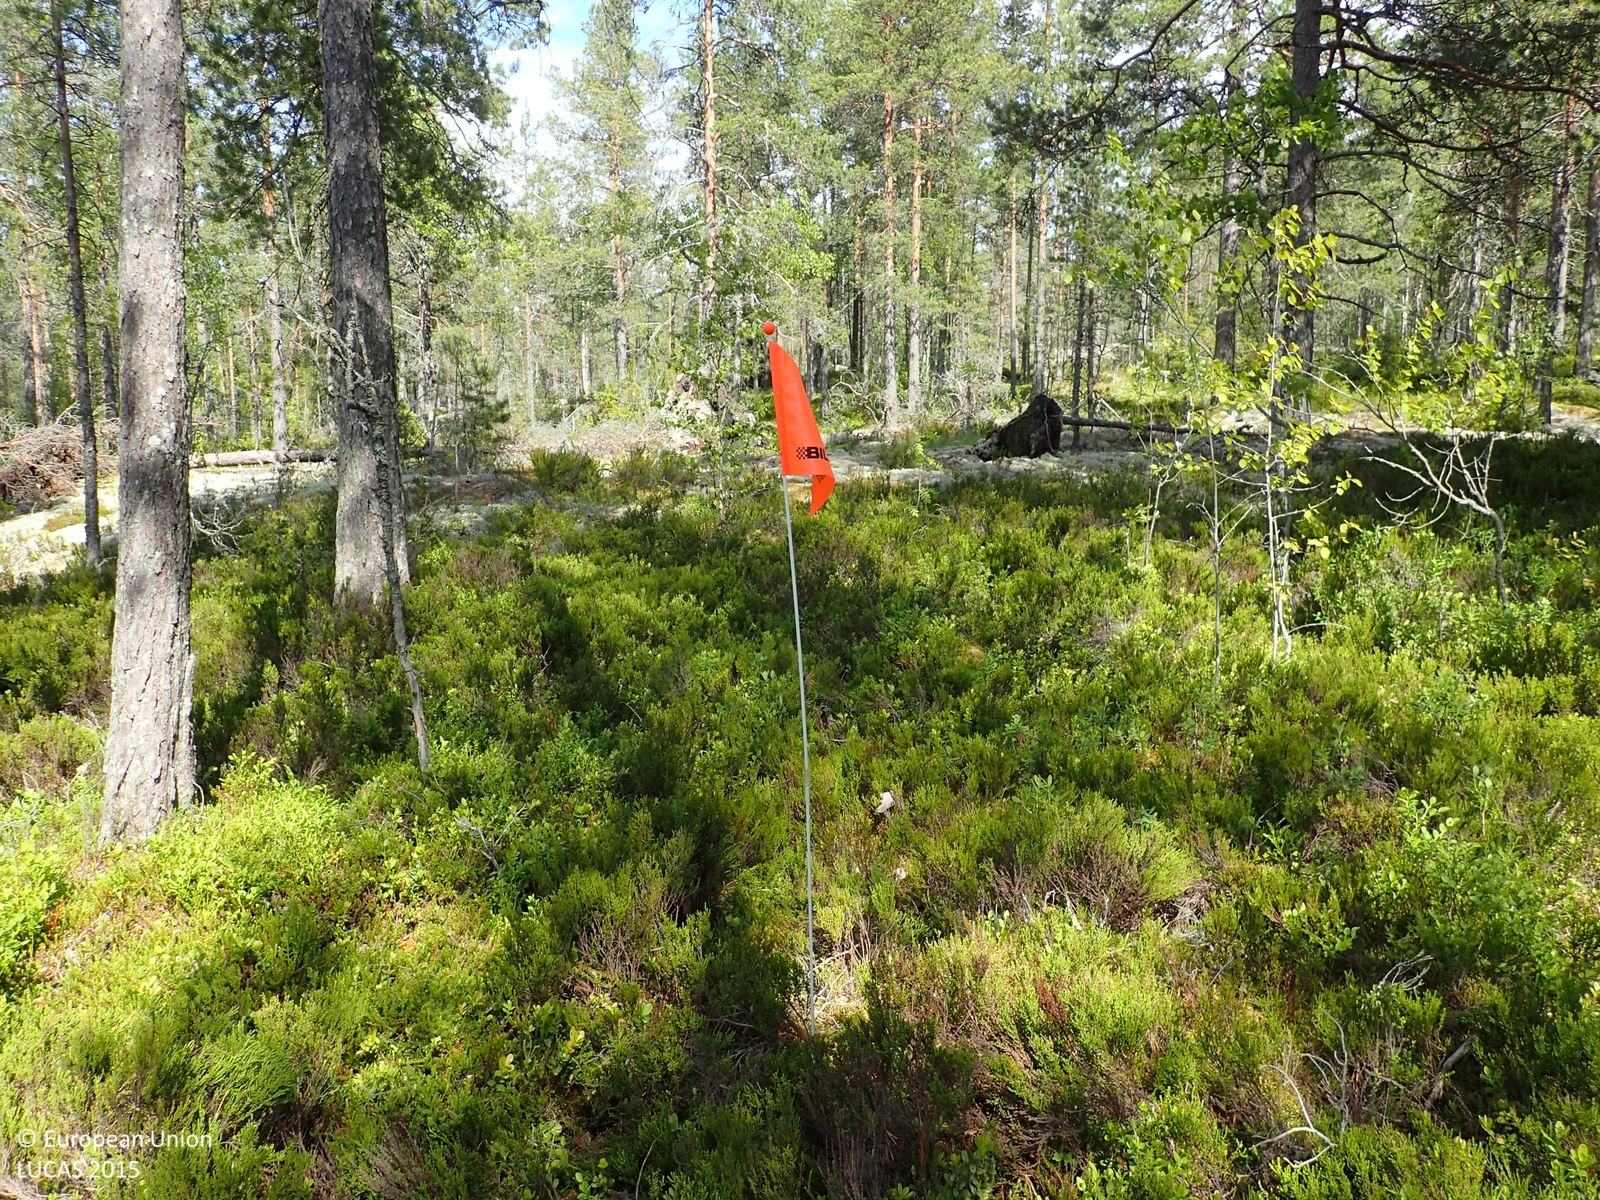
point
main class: Woodland
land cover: Pine dominated coniferous woodland
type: boreal forest
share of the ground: 25 - 50 %
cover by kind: shrubs 50 %, coniferous forest trees 40 %, broadleaved forest trees 5 %, lichens and mosses 5 %
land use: Forestry
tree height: > 5 m
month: June
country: FI
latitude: 62.4327
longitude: 21.6475
